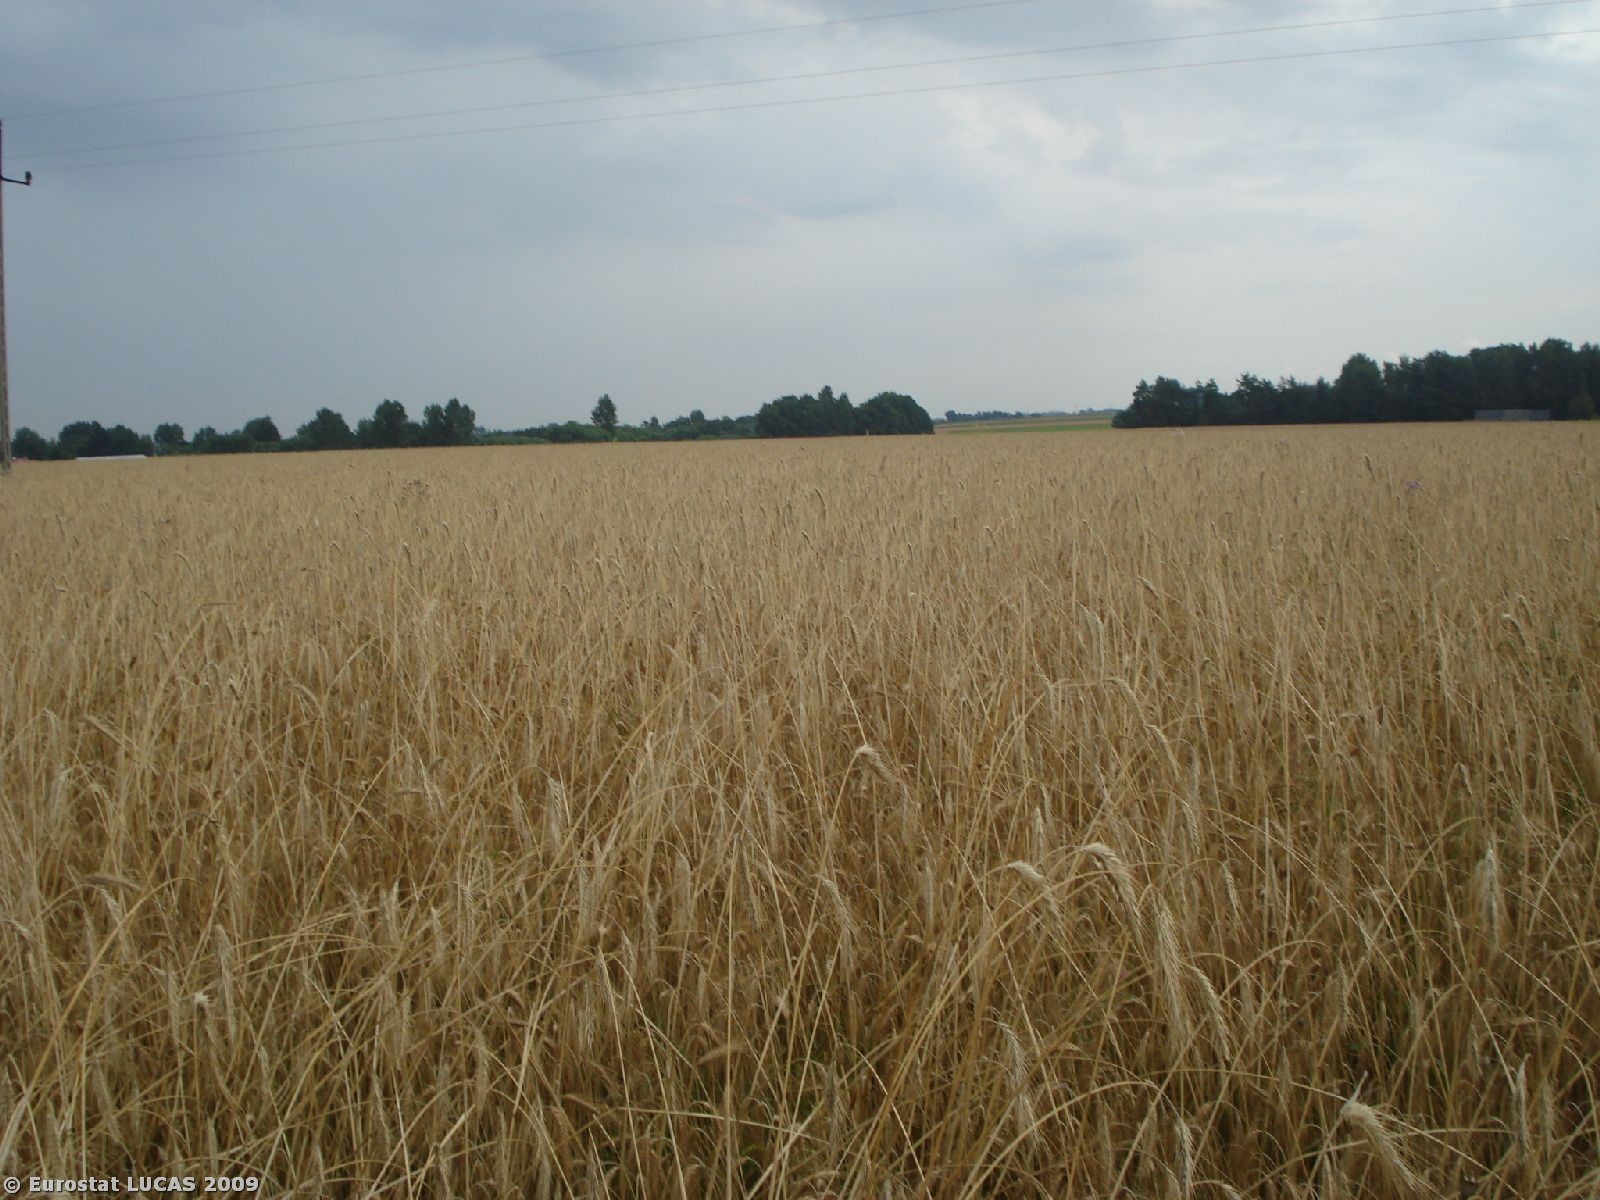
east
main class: Cropland
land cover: Triticale
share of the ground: 25 - 50 %
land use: Agriculture (excluding fallow land and kitchen gardens)
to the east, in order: Triticale; Electric lines; Triticale; Grass margins; Common wheat
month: August
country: PL
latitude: 52.7430
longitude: 22.4035
